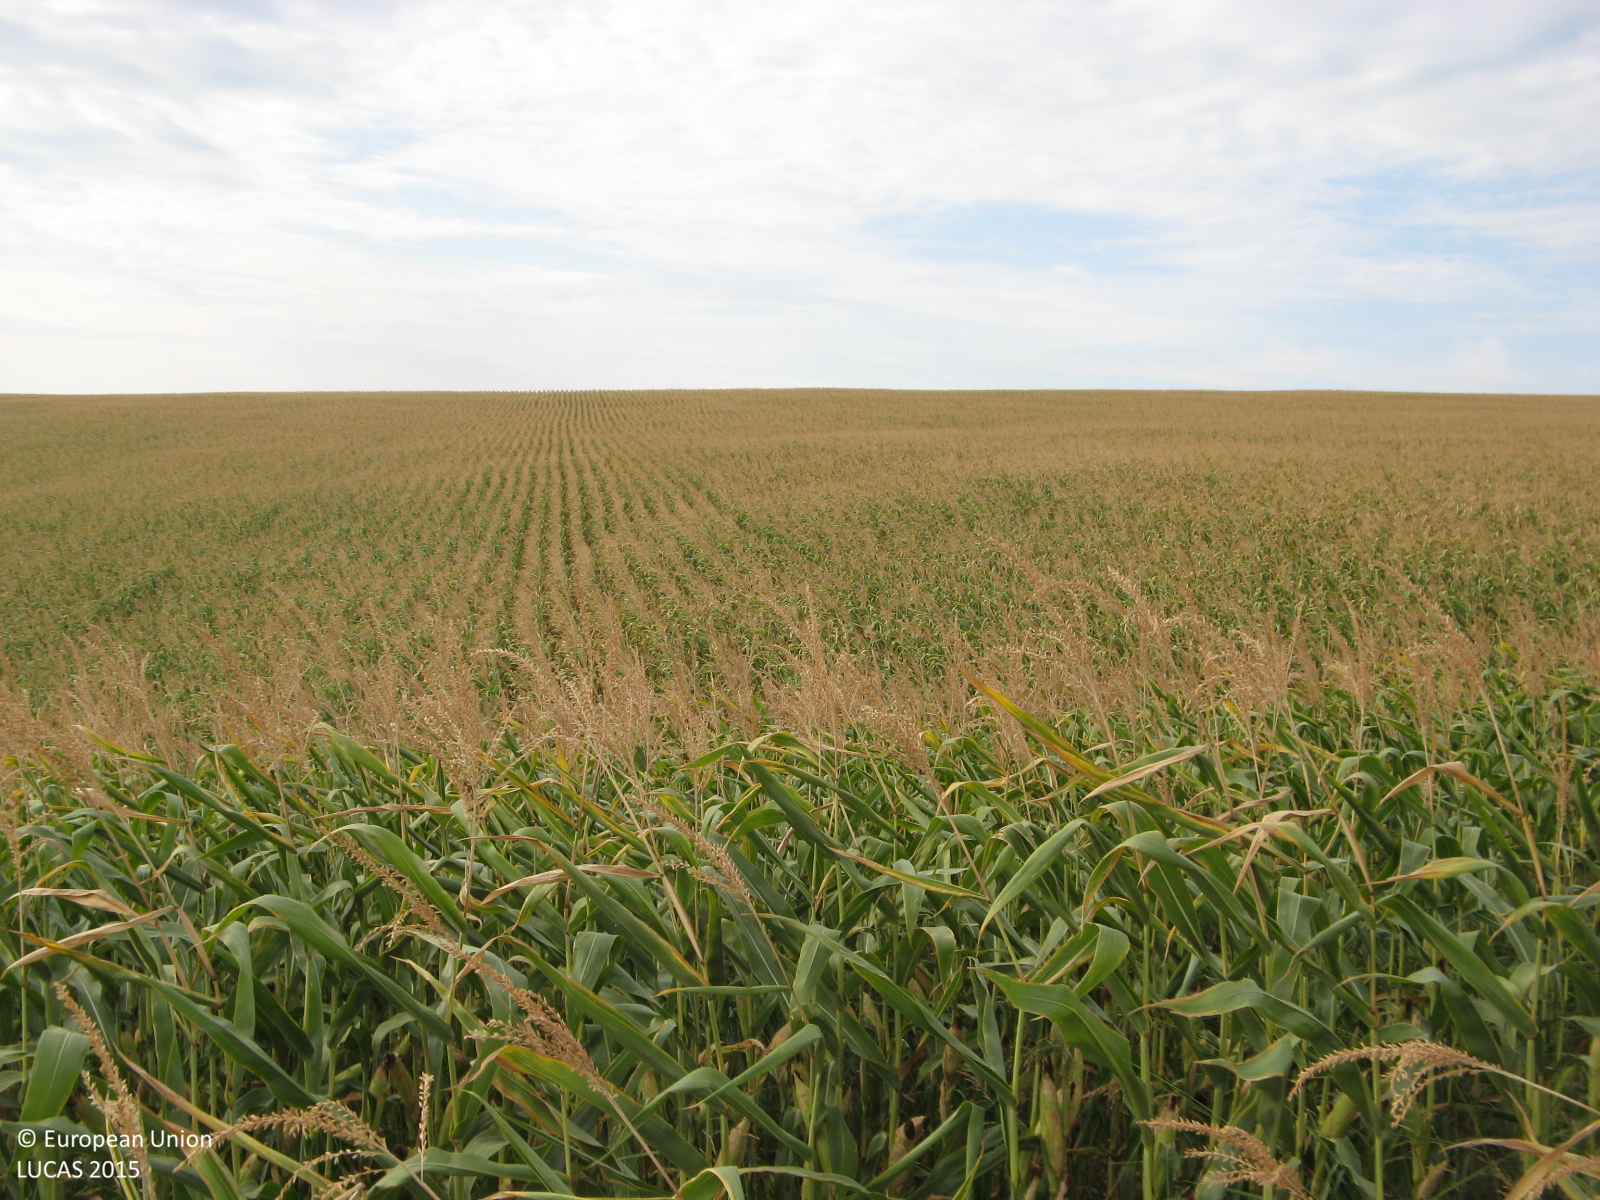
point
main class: Cropland
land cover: Maize
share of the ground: > 75 %
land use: Agriculture (excluding fallow land and kitchen gardens)
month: August
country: BG
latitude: 43.6652
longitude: 25.9040
